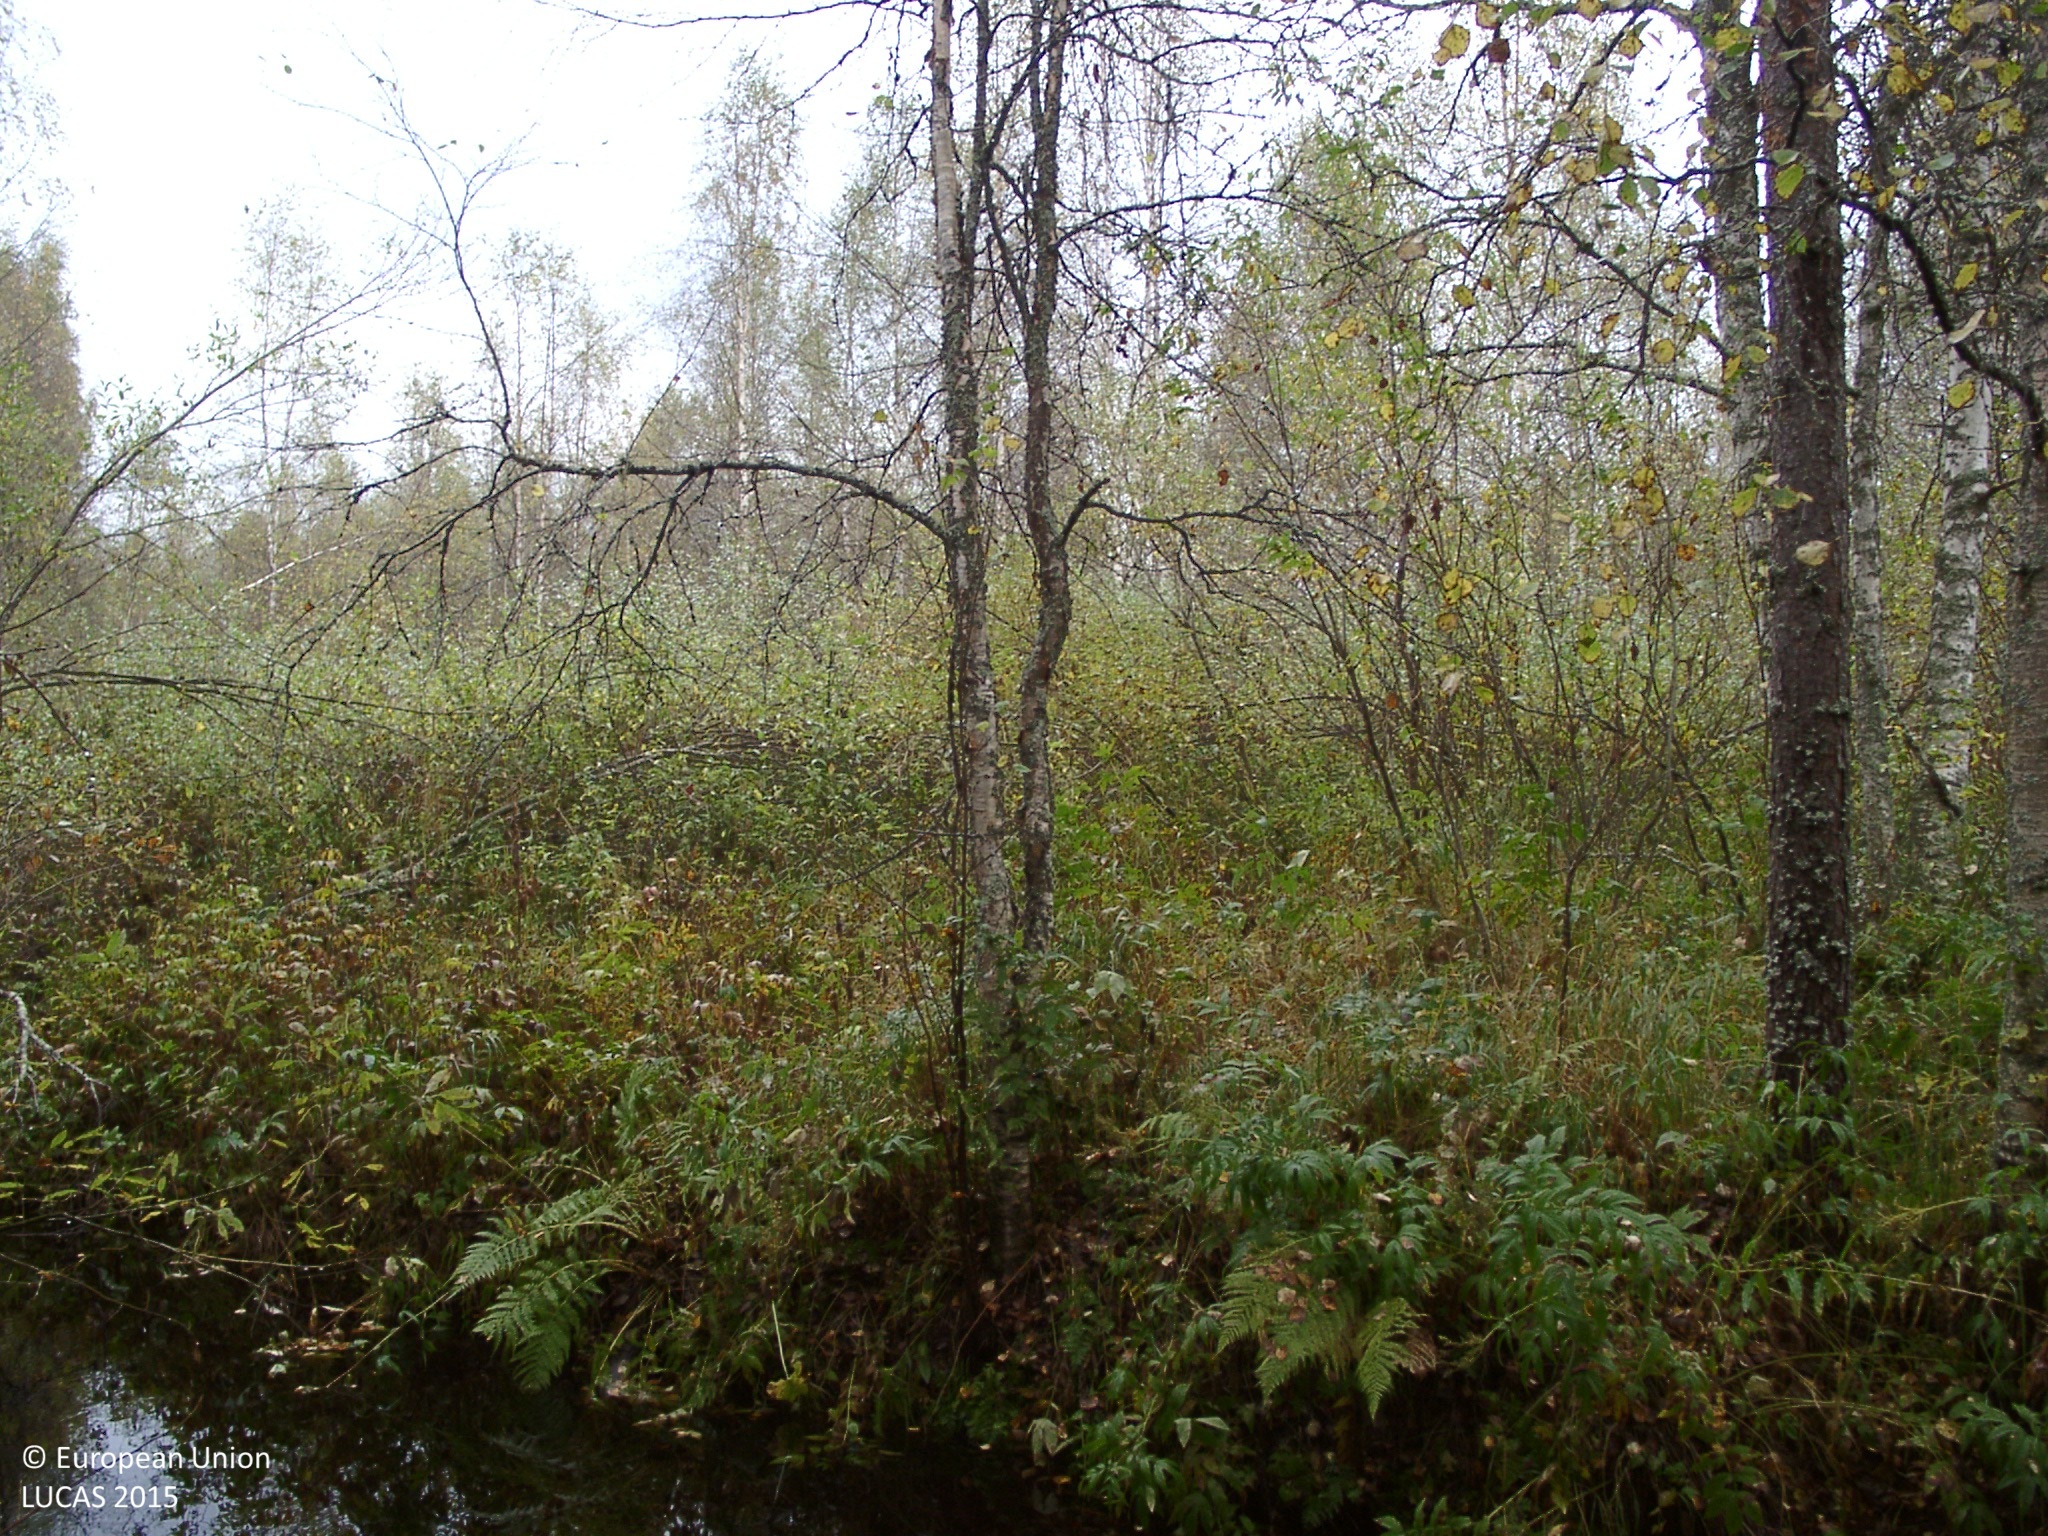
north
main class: Shrubland
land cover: Shrubland with sparse tree cover
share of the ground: 25 - 50 %
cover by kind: herbaceous plants 55 %, shrubs 40 %, broadleaved forest trees 5 %
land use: Forestry
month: September
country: FI
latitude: 62.7441
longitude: 25.3129
